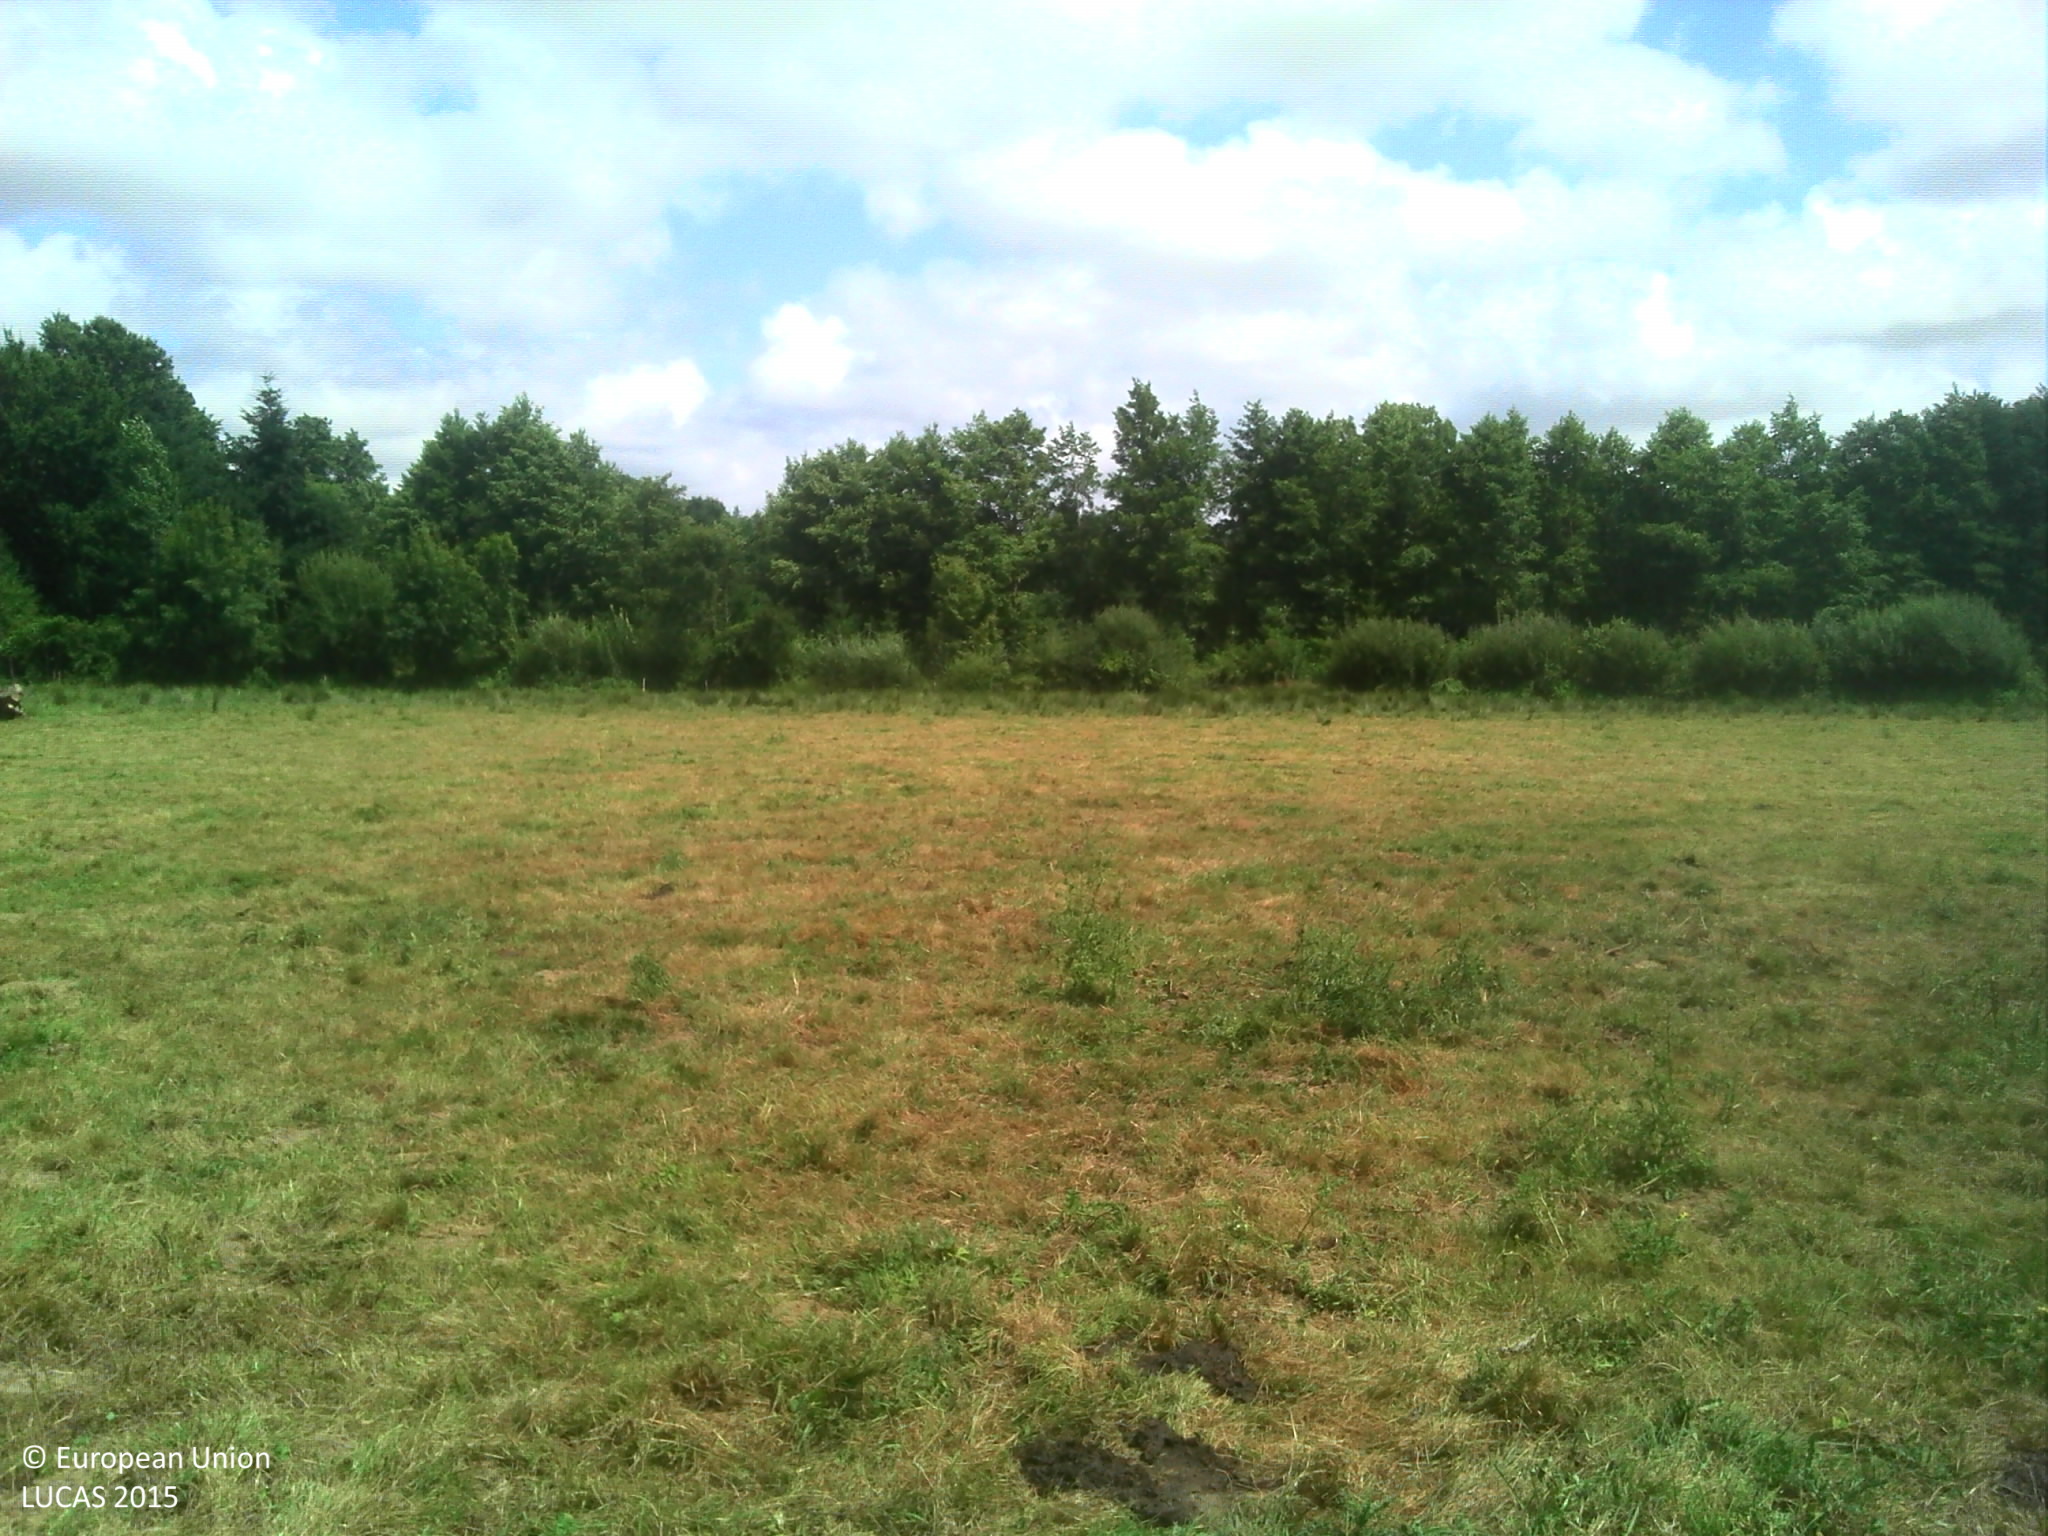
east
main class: Grassland
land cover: Grassland without tree/shrub cover
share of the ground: > 75 %
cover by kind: herbaceous plants 100 %
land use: Agriculture (excluding fallow land and kitchen gardens)
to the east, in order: Grassland without tree/shrub cover; Ponds and wetlands; Fences; Abandoned hedges; Tracks; Lines of trees; Grassland without tree/shrub cover; Lines of trees; Inland fresh water bodies; Broadleaved woodland; Inland fresh water bodies
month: July
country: FR
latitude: 46.5074
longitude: -1.3609
